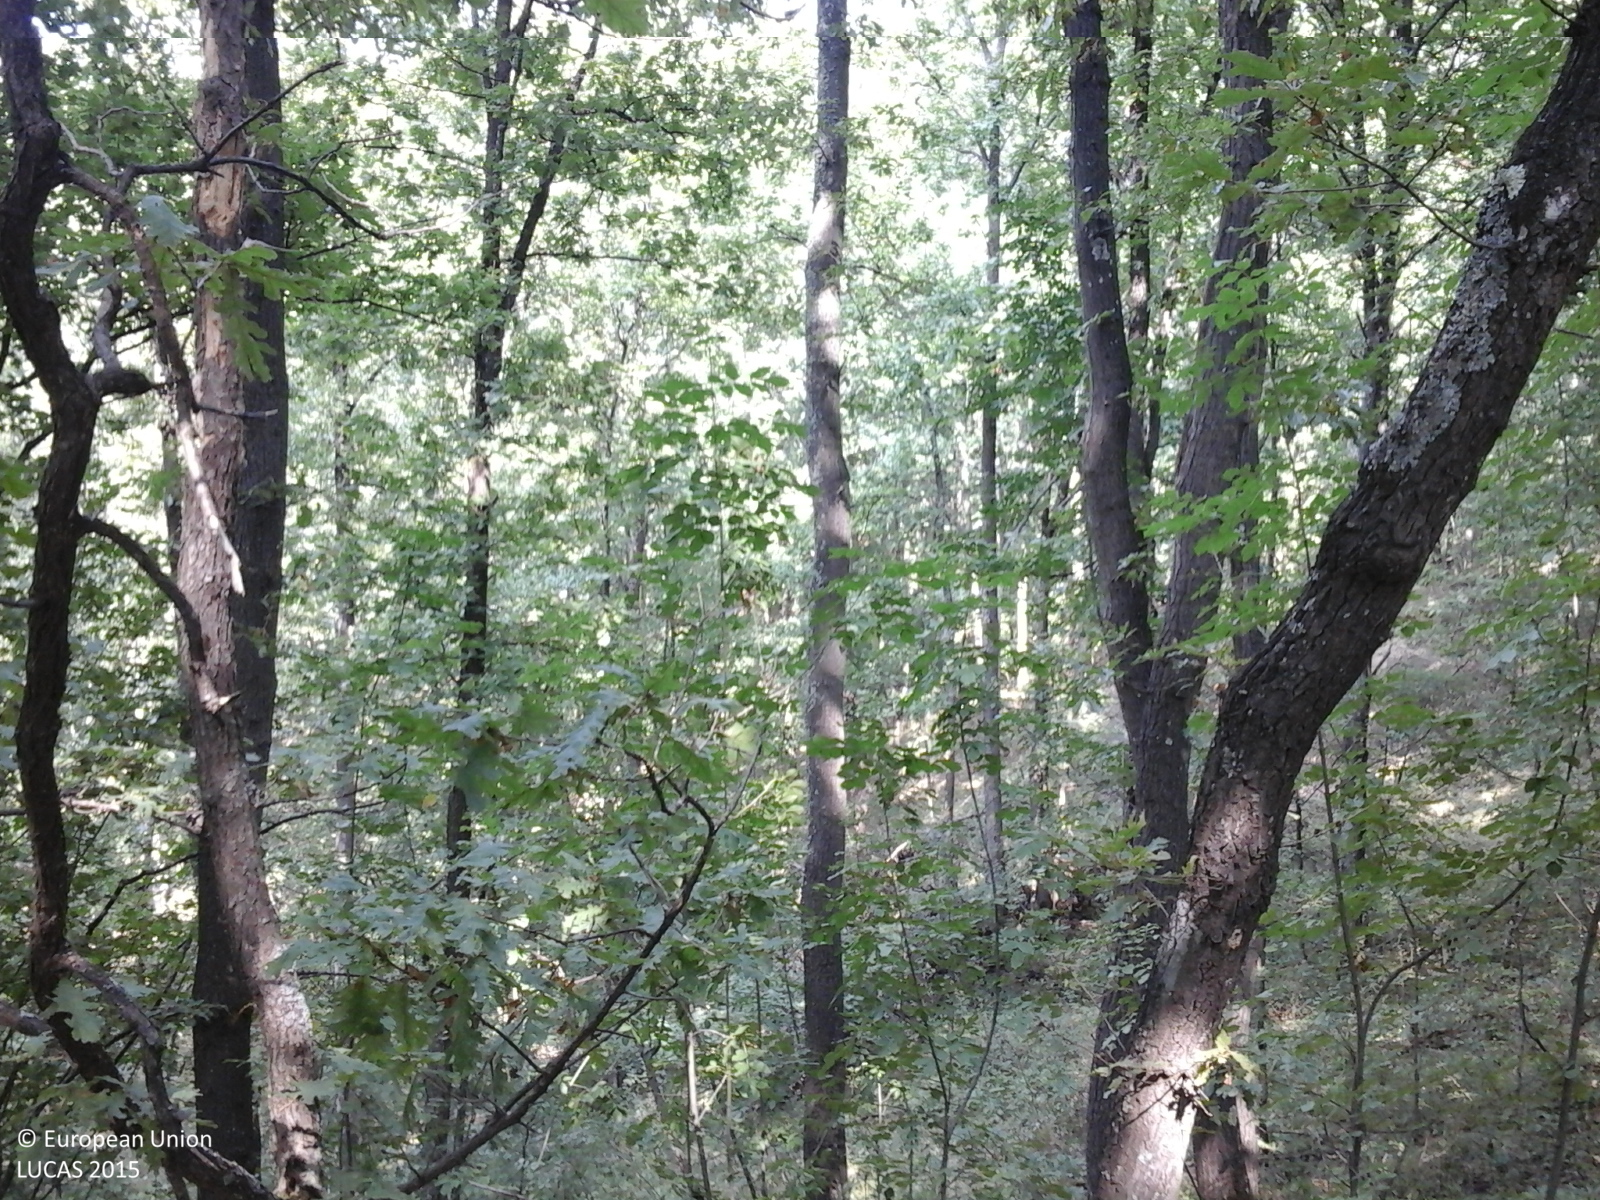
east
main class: Woodland
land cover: Broadleaved woodland
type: acidophilous oak and oak-birch forest
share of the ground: > 75 %
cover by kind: broadleaved forest trees 100 %
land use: Forestry
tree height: > 5 m
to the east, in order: Broadleaved woodland
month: August
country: RO
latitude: 44.6954
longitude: 23.8537
